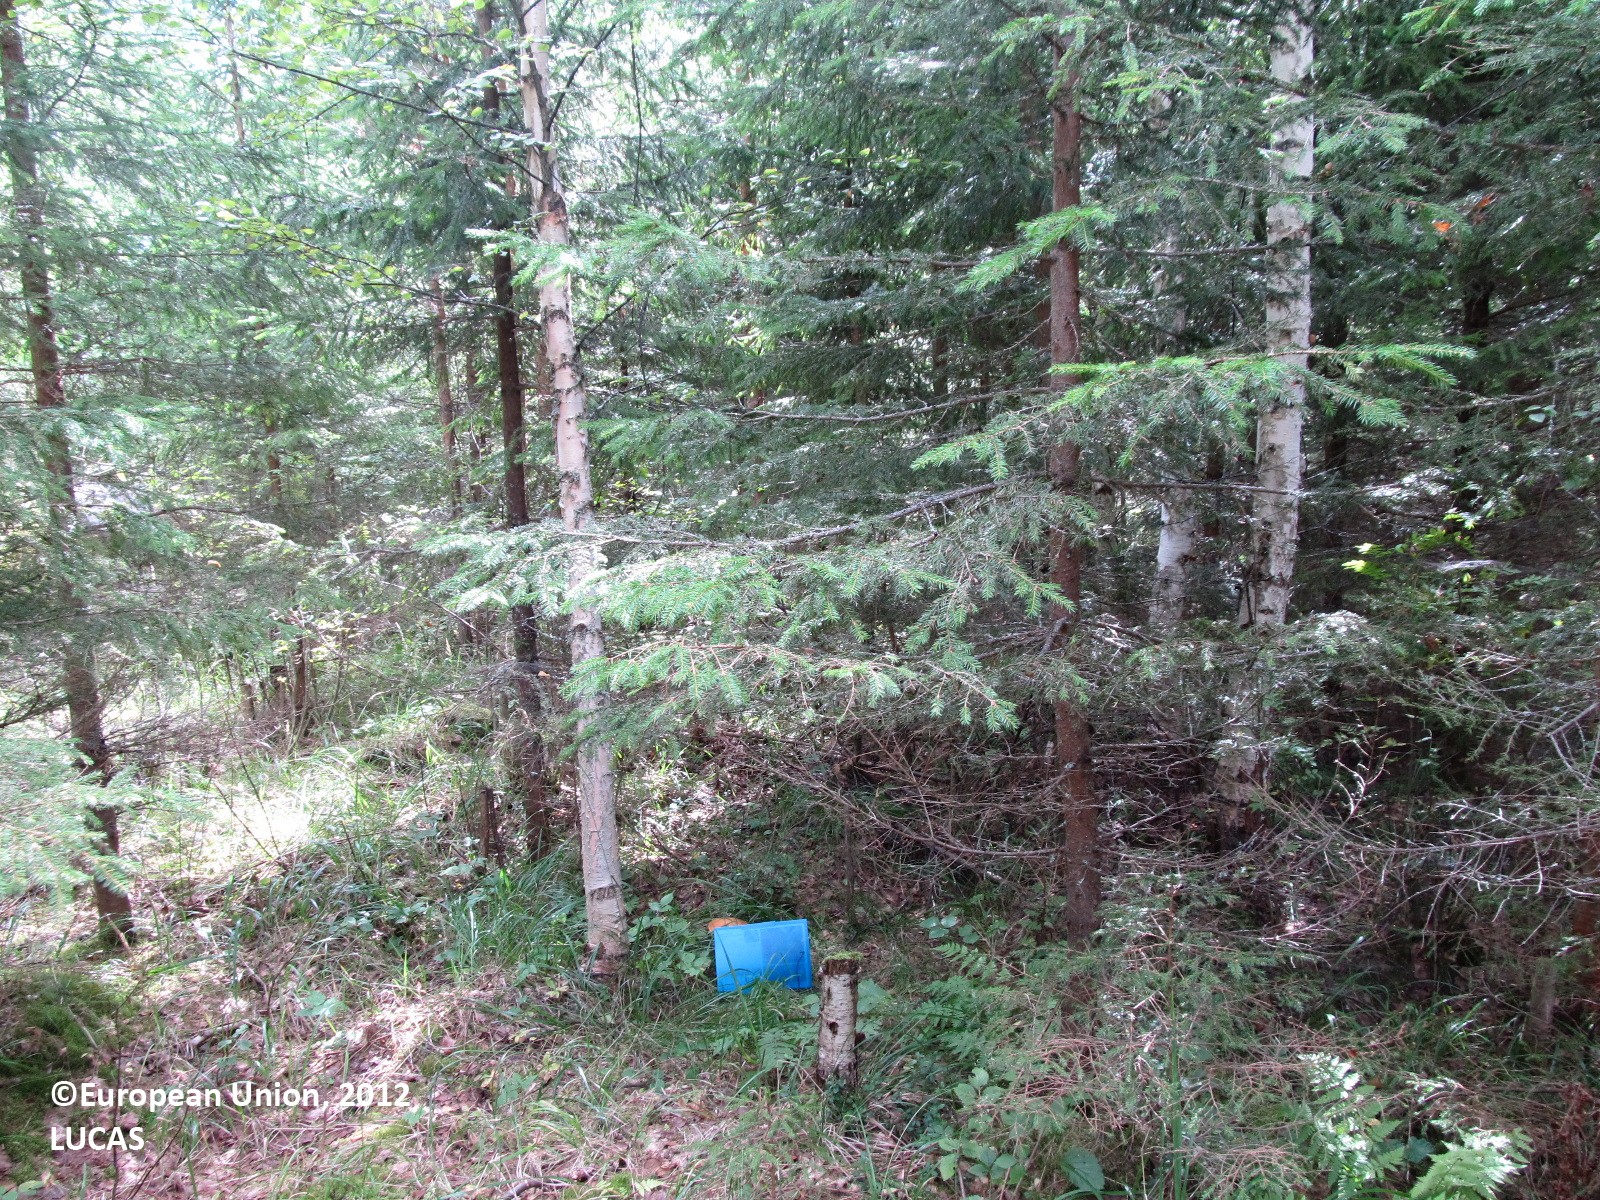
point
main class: Woodland
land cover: Spruce dominated coniferous woodland
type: boreal forest
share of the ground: 50 - 75 %
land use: Forestry
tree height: > 5 m
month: August
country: FI
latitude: 62.2183
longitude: 28.4534
